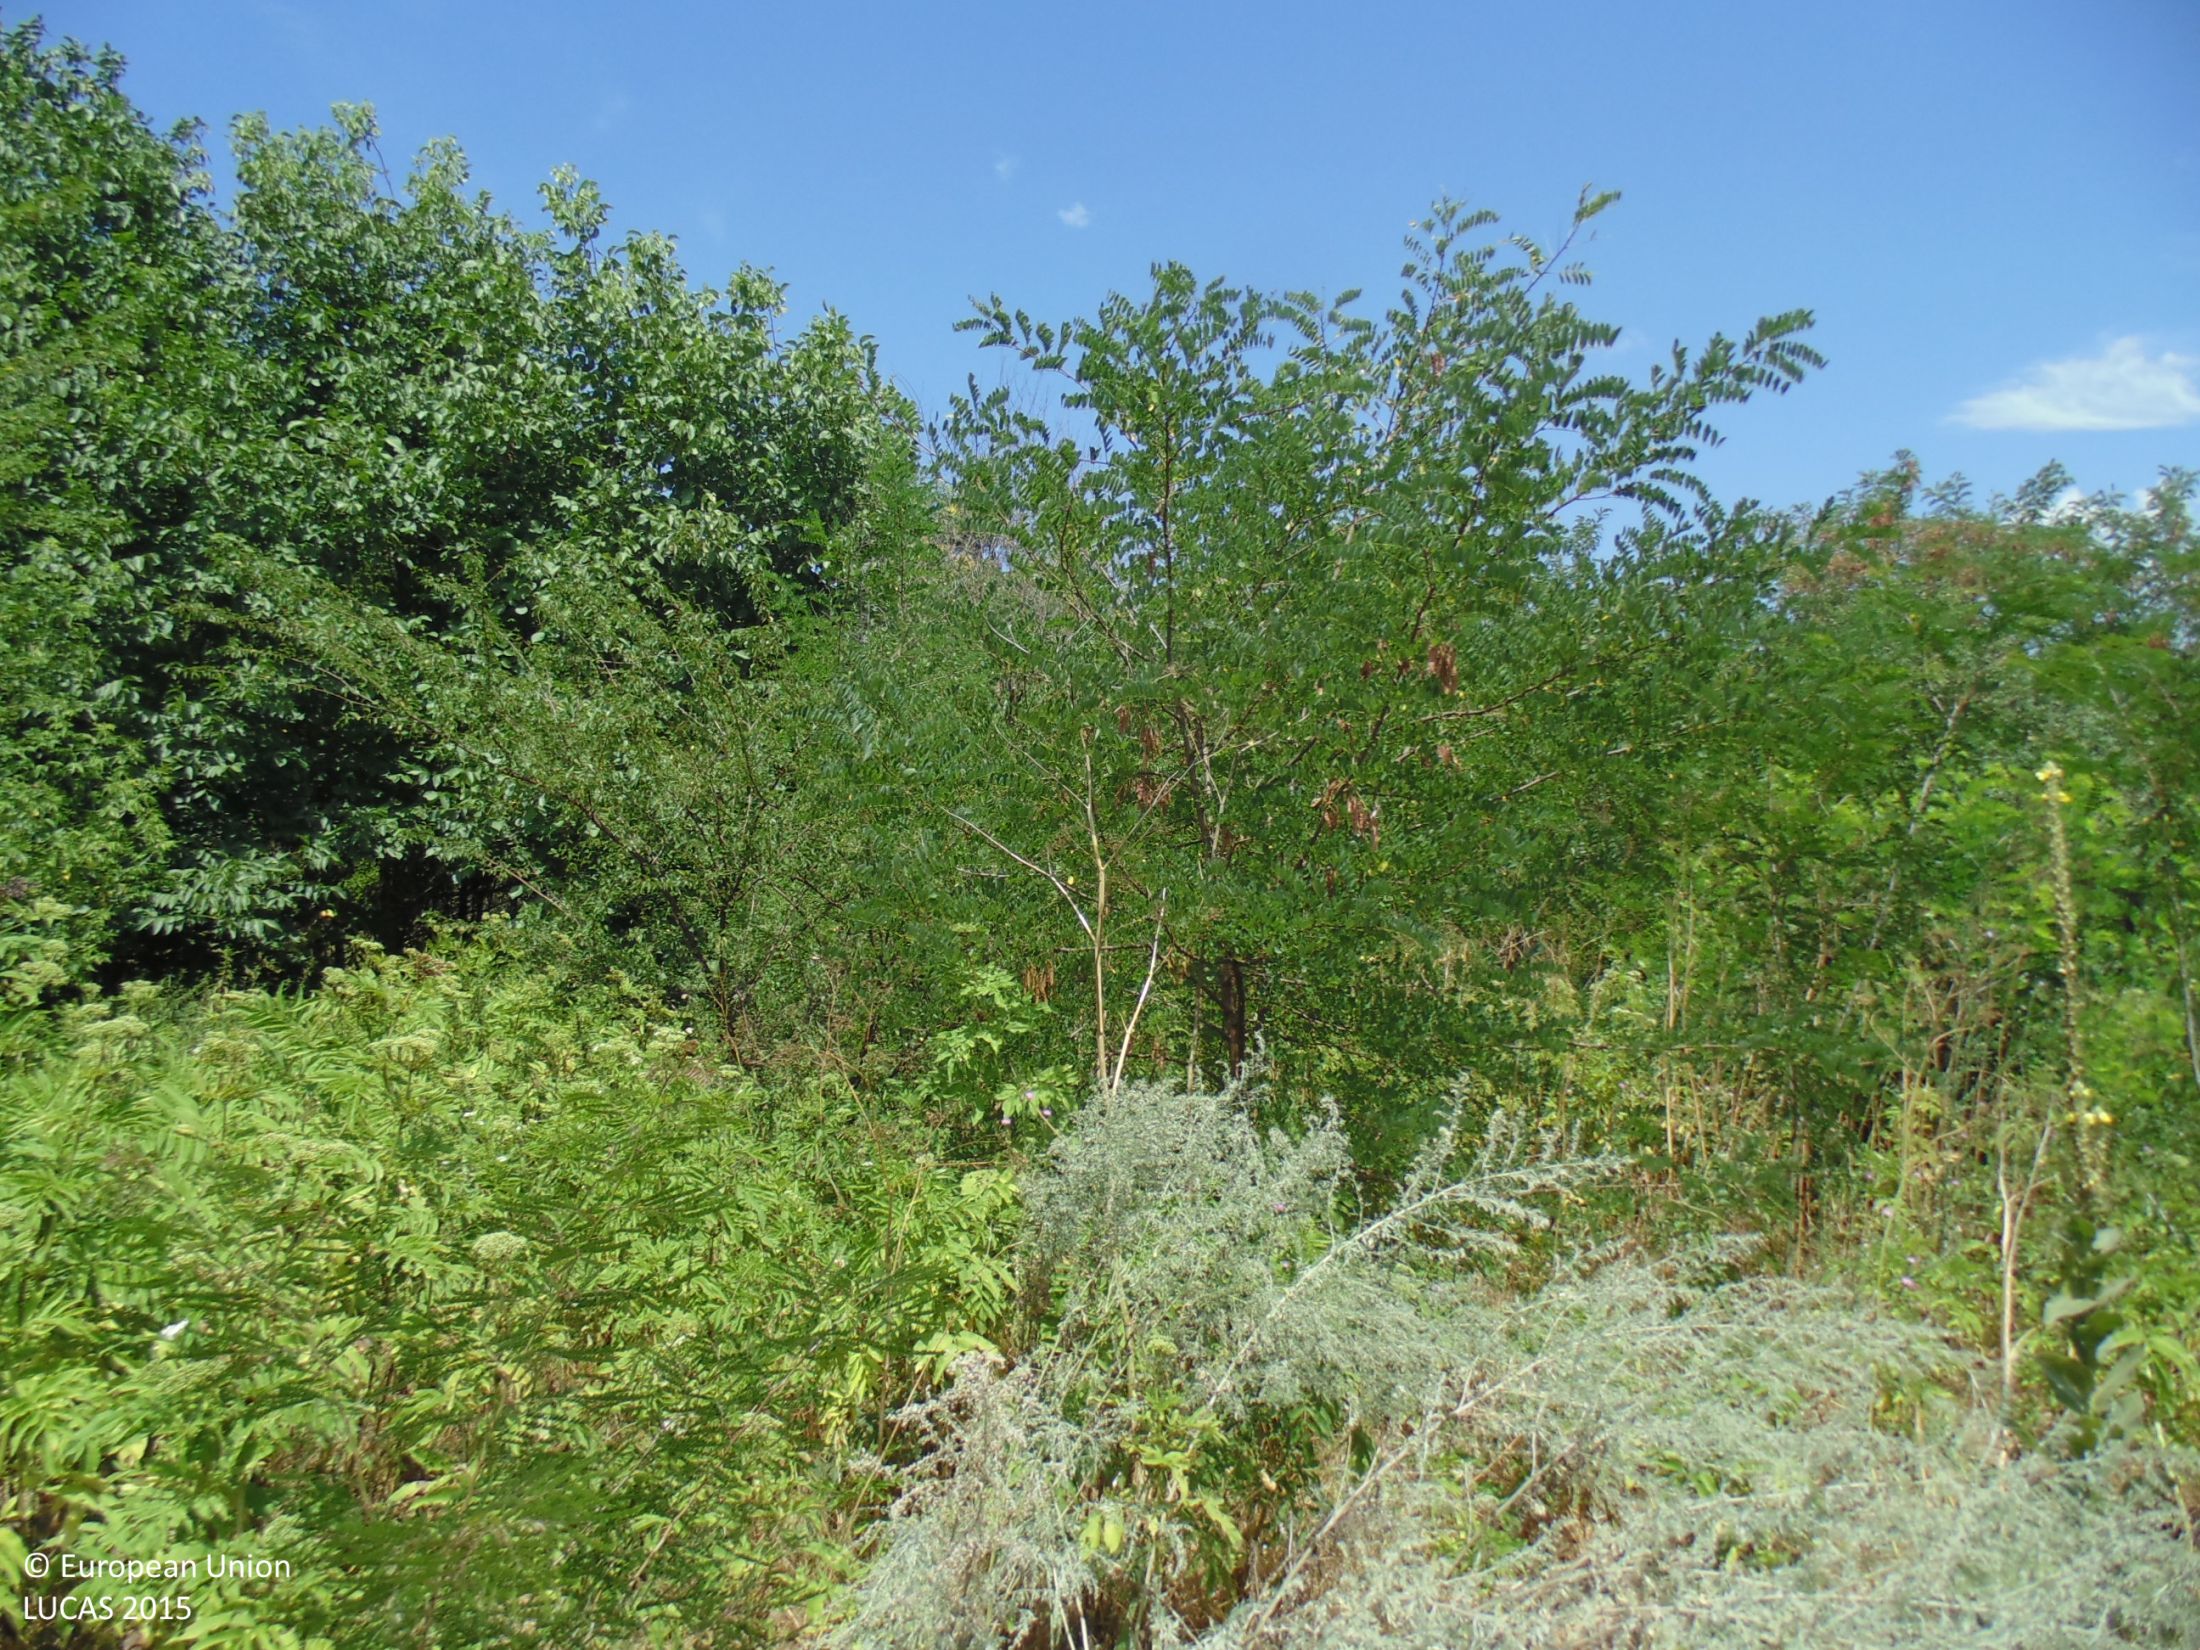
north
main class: Woodland
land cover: Broadleaved woodland
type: mesophytic deciduous forest
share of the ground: > 75 %
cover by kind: broadleaved forest trees 60 %, herbaceous plants 25 %, shrubs 15 %
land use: Semi-natural and natural areas not in use
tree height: > 5 m
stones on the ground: < 10 %
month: August
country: BG
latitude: 43.6135
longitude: 28.1810
